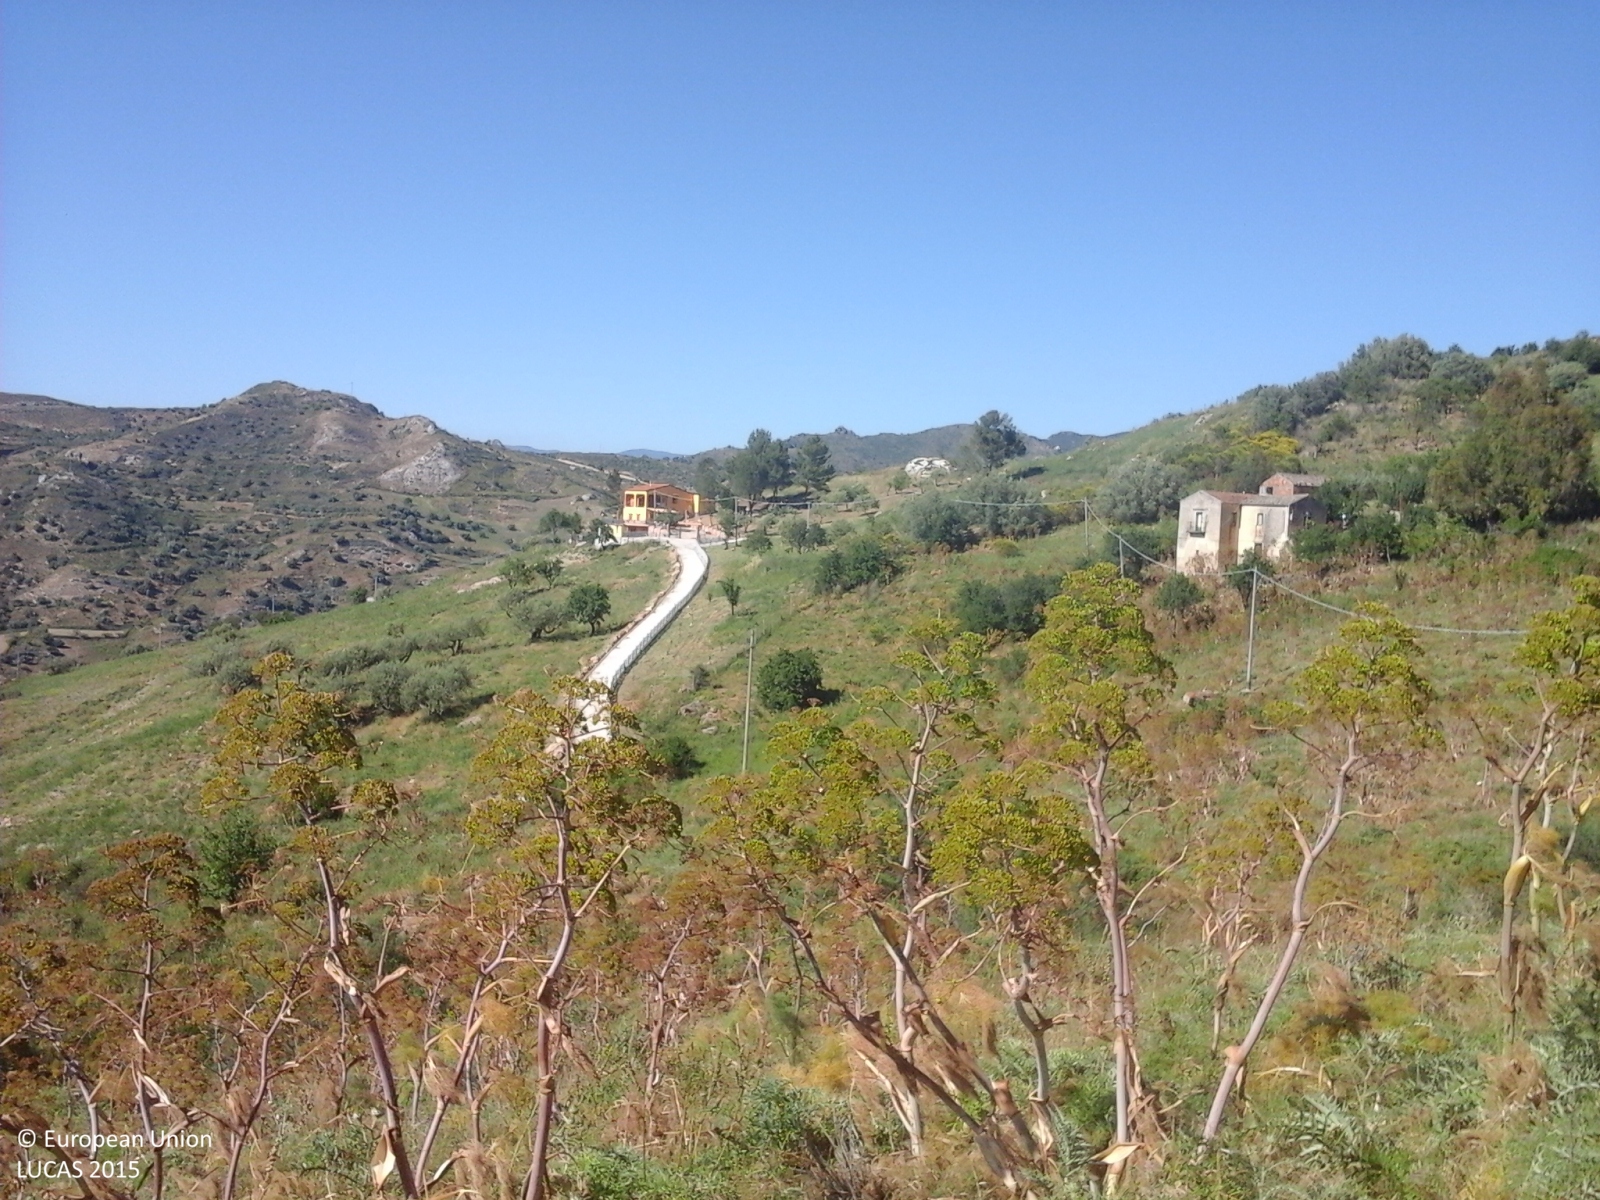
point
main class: Shrubland
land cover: Shrubland with sparse tree cover
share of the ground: > 75 %
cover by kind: herbaceous plants 55 %, shrubs 40 %, broadleaved forest trees 5 %
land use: Agriculture (excluding fallow land and kitchen gardens)
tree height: > 5 m
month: May
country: IT
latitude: 37.7171
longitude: 14.4268
